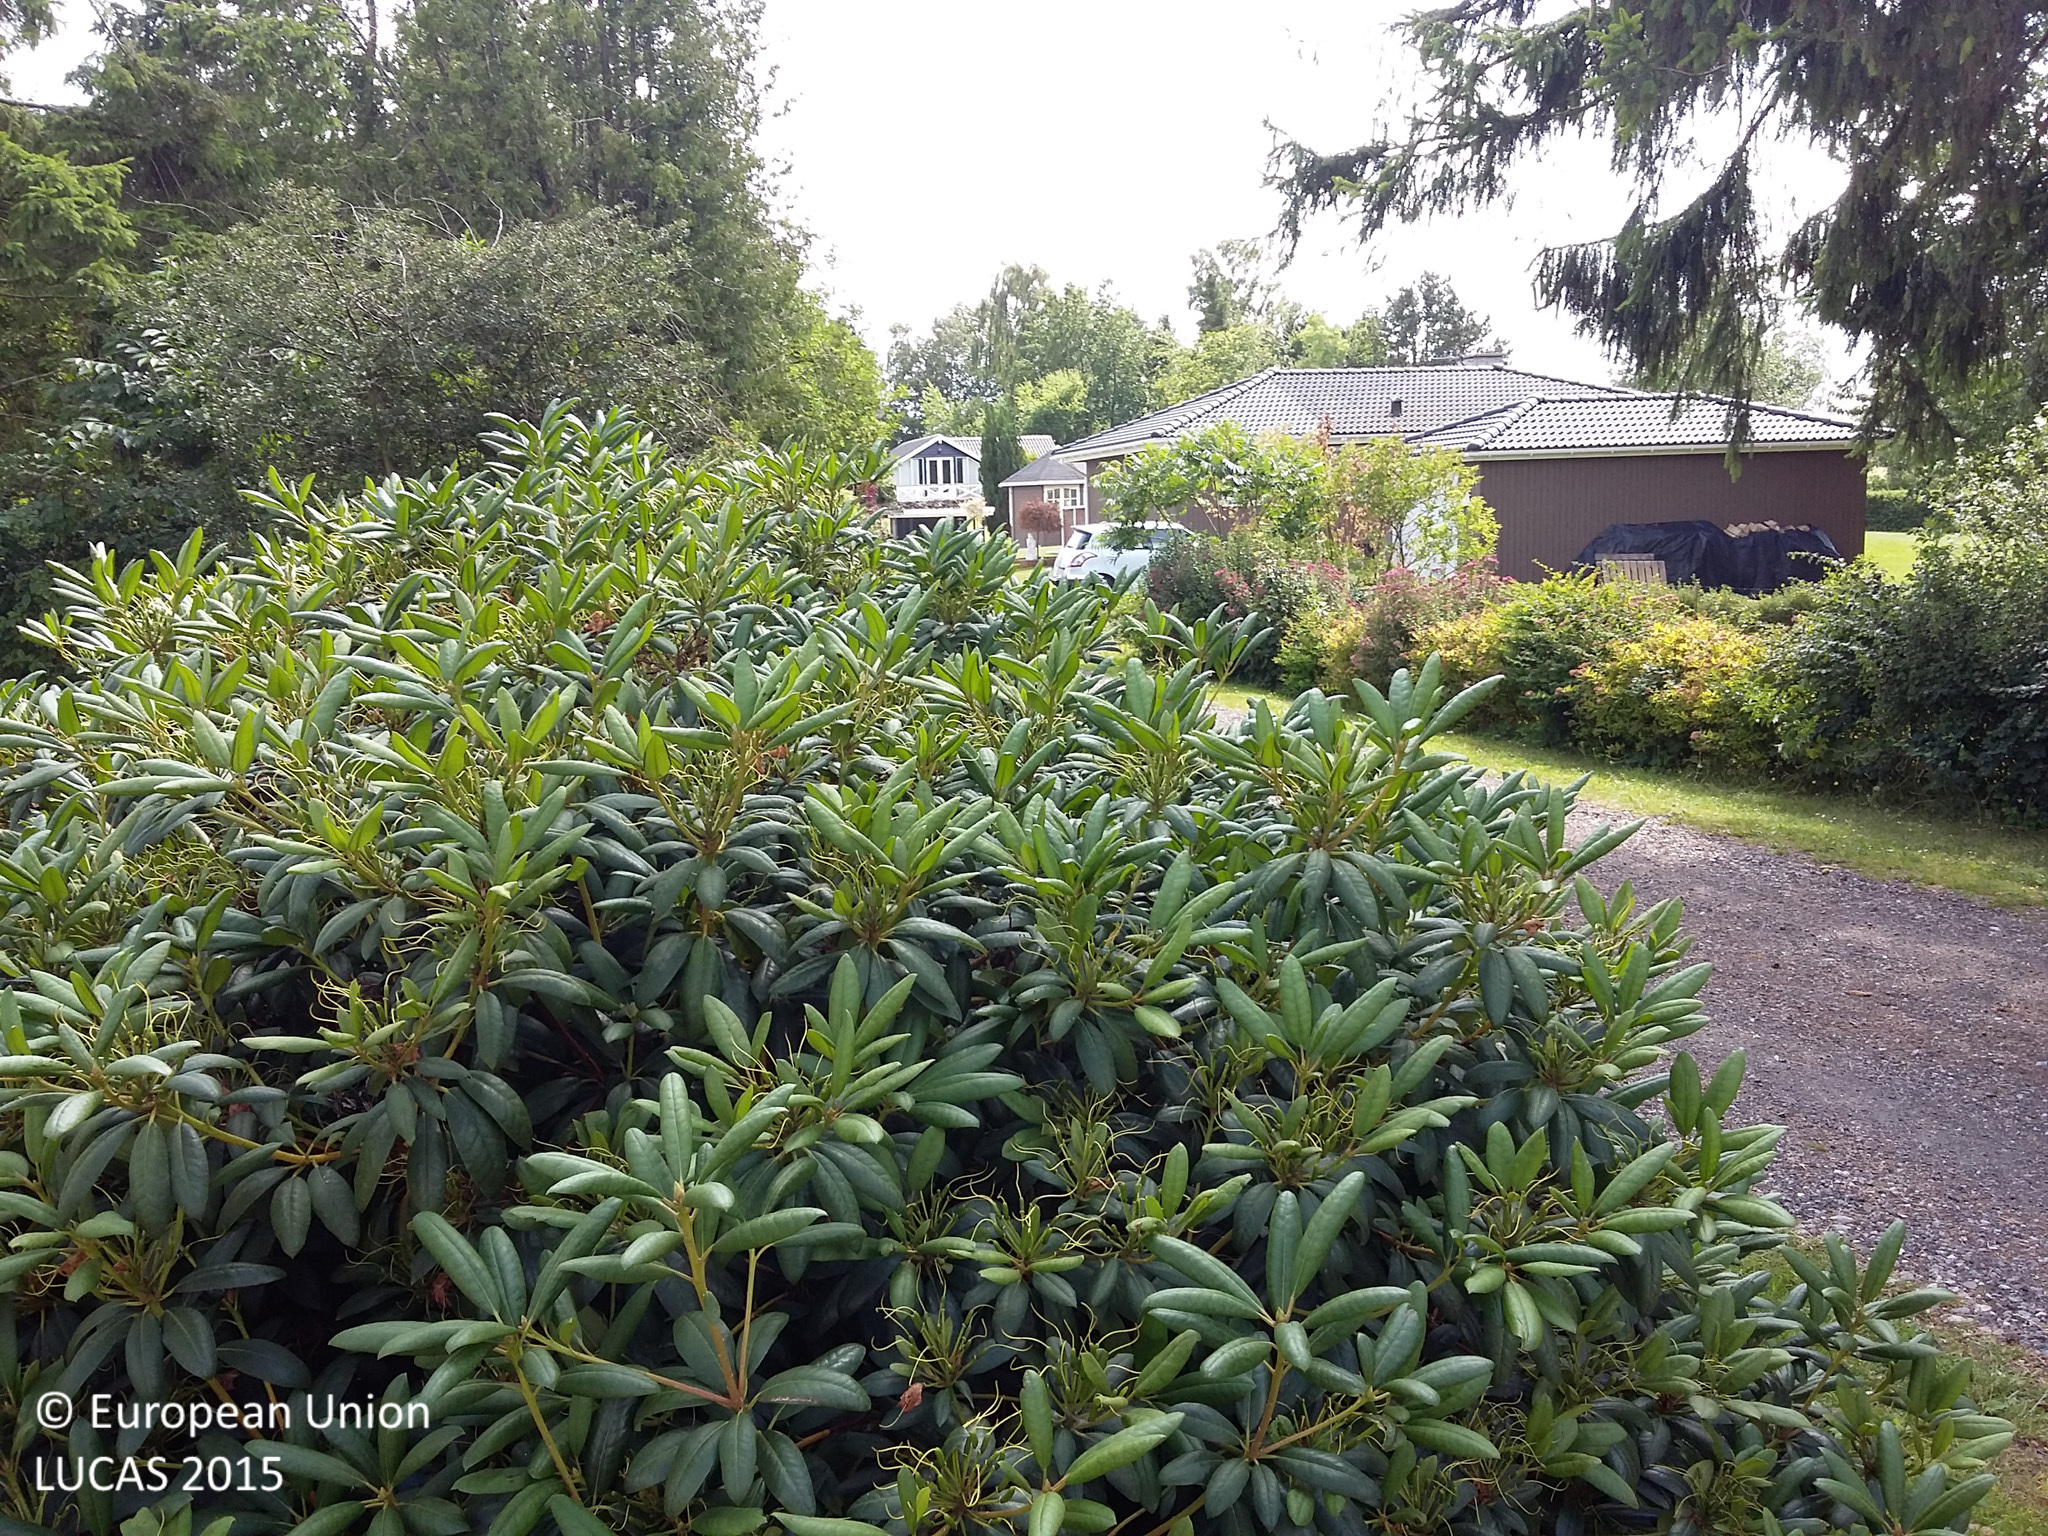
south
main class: Grassland
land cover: Grassland without tree/shrub cover
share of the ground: > 75 %
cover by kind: herbaceous plants 100 %
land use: Residential
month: July
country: DK
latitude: 55.7997
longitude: 11.6415
